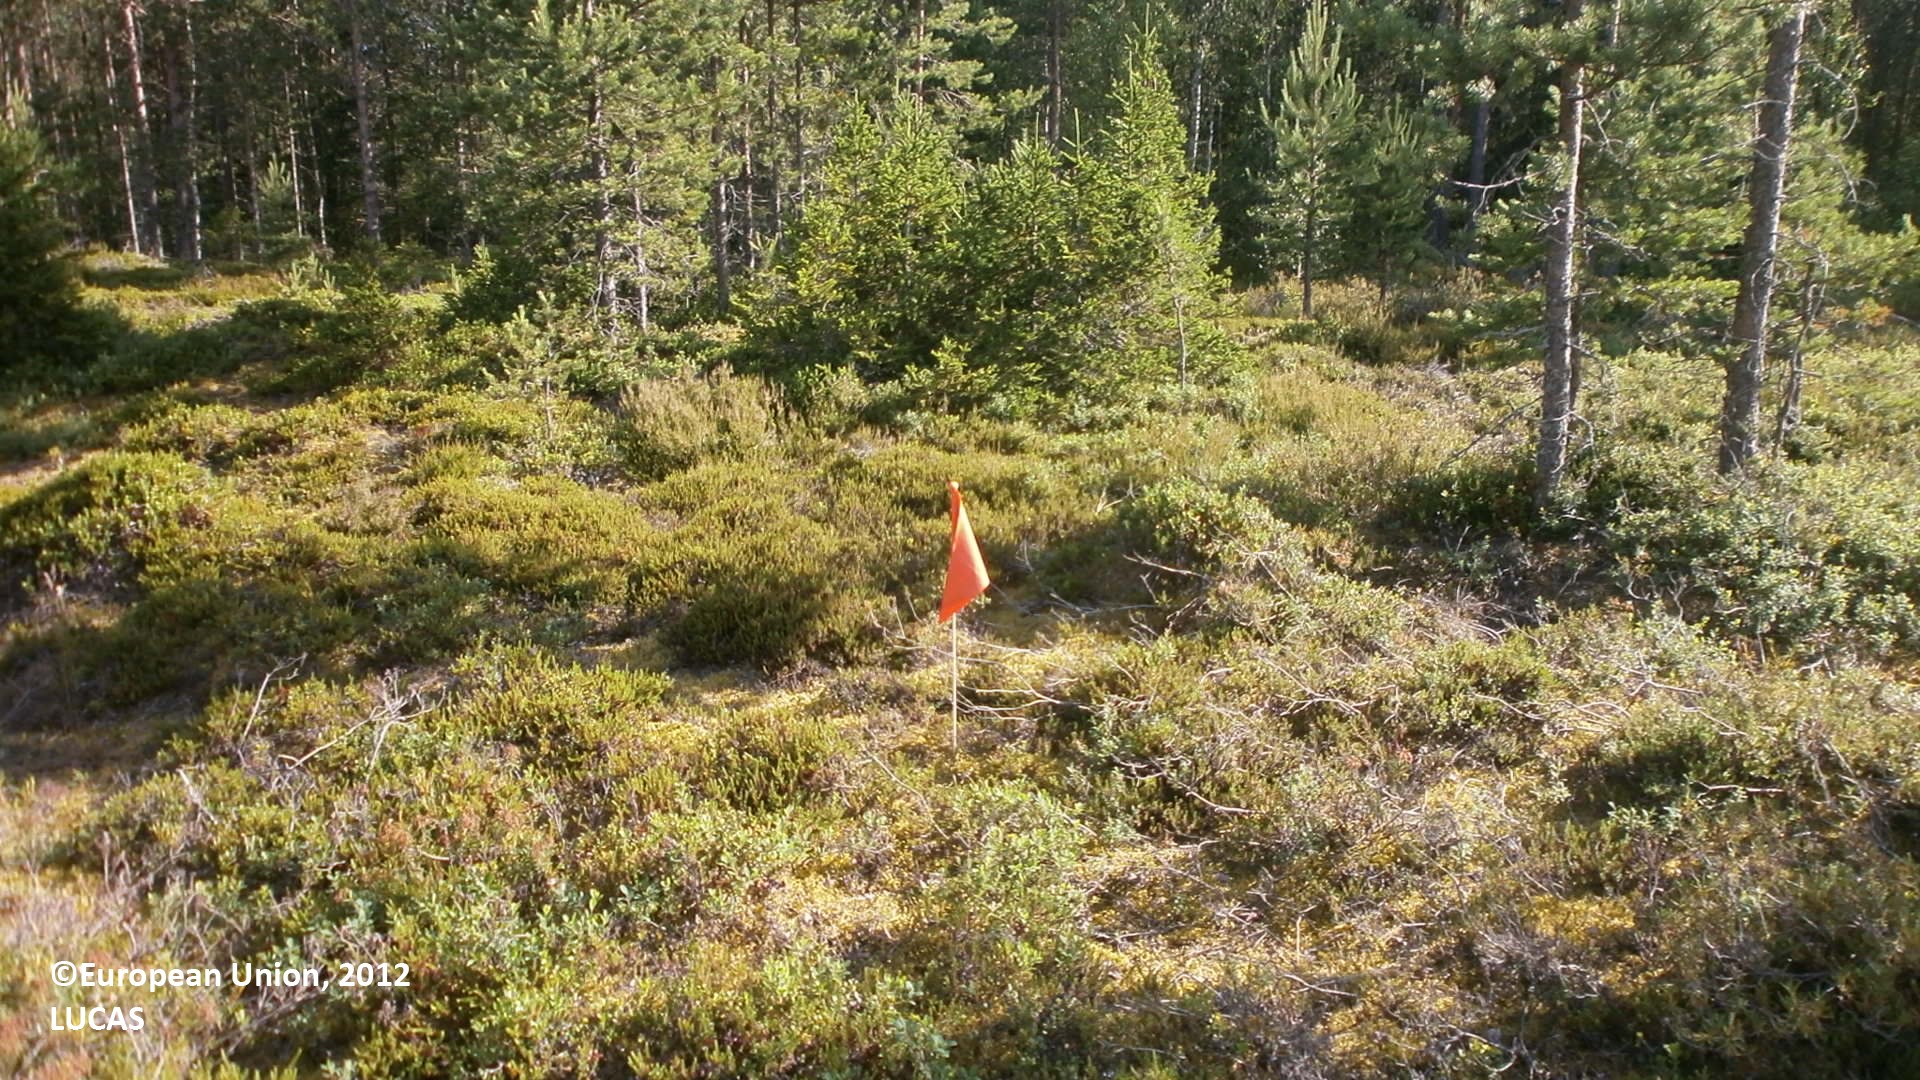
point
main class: Woodland
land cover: Pine dominated mixed woodland
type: boreal forest
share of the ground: 10 - 25 %
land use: Forestry
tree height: > 5 m
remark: Clear cut
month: July
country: FI
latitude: 64.4395
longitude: 24.1683
